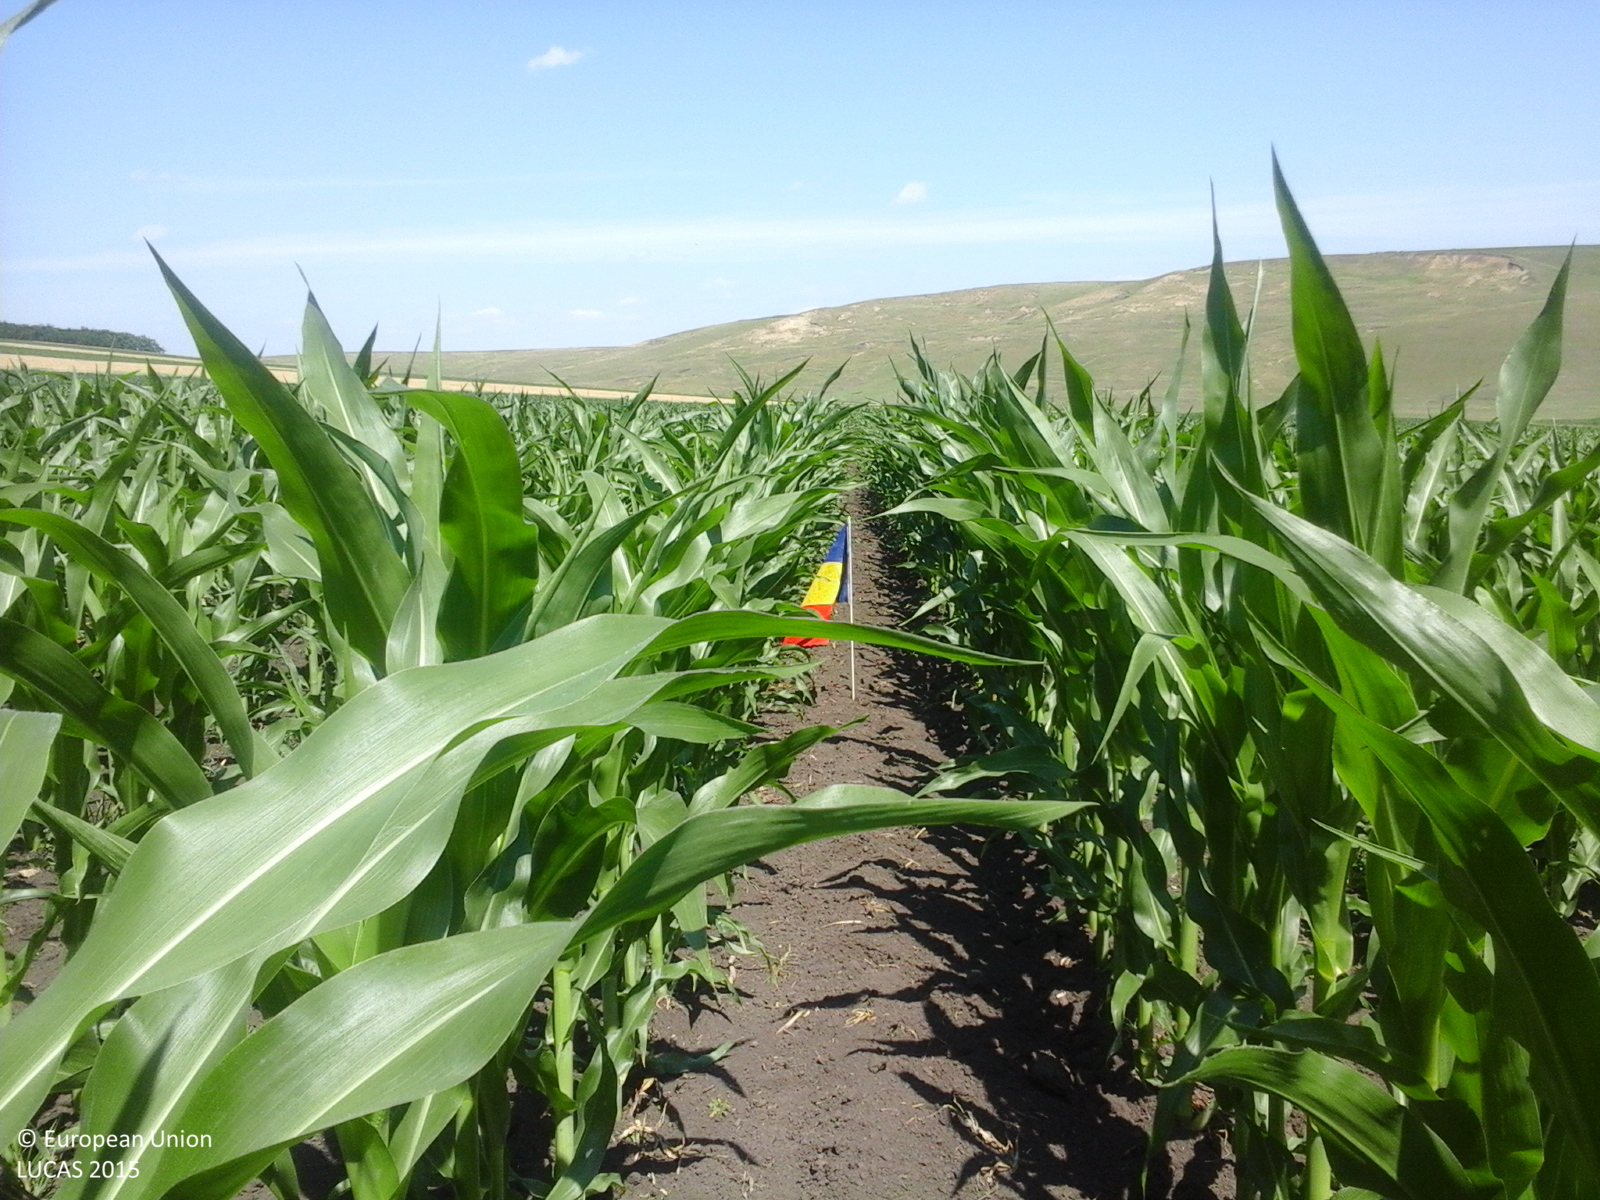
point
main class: Cropland
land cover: Maize
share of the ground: > 75 %
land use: Agriculture (excluding fallow land and kitchen gardens)
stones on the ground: < 10 %
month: June
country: RO
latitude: 47.7244
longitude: 27.1885
